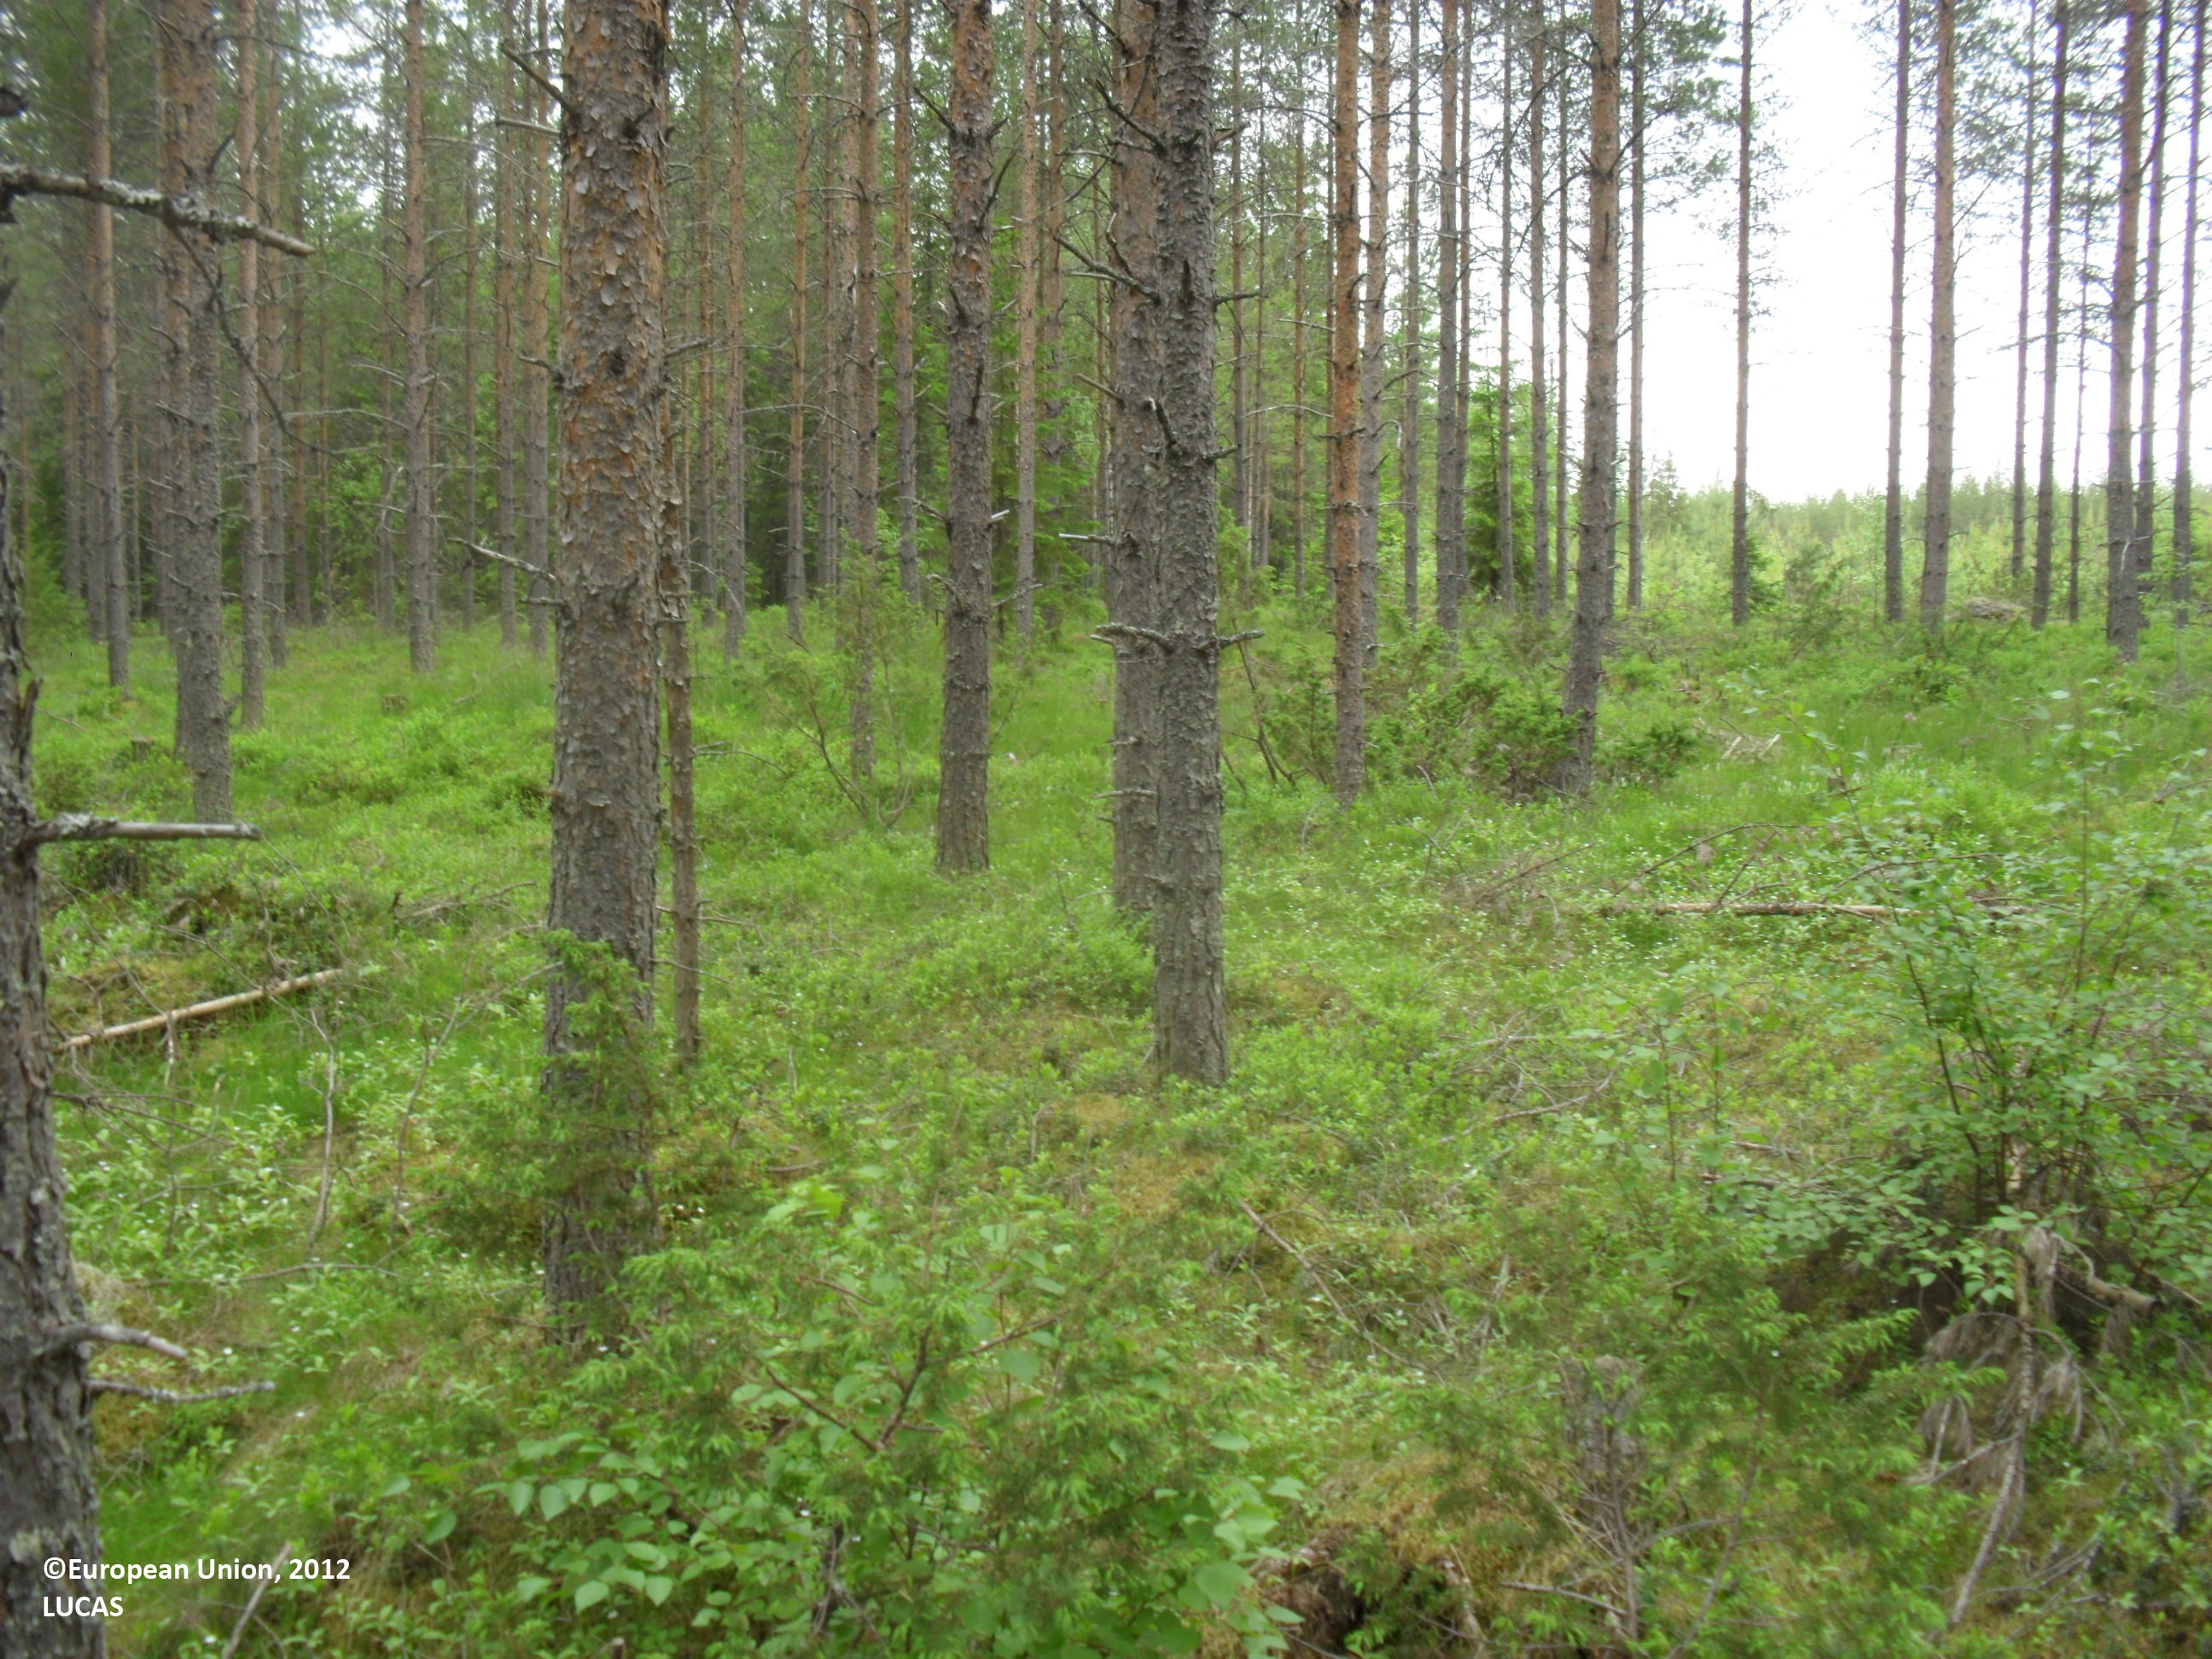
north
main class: Woodland
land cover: Pine dominated coniferous woodland
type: boreal forest
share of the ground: 25 - 50 %
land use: Forestry
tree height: > 5 m
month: June
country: FI
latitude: 63.4941
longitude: 23.2122
